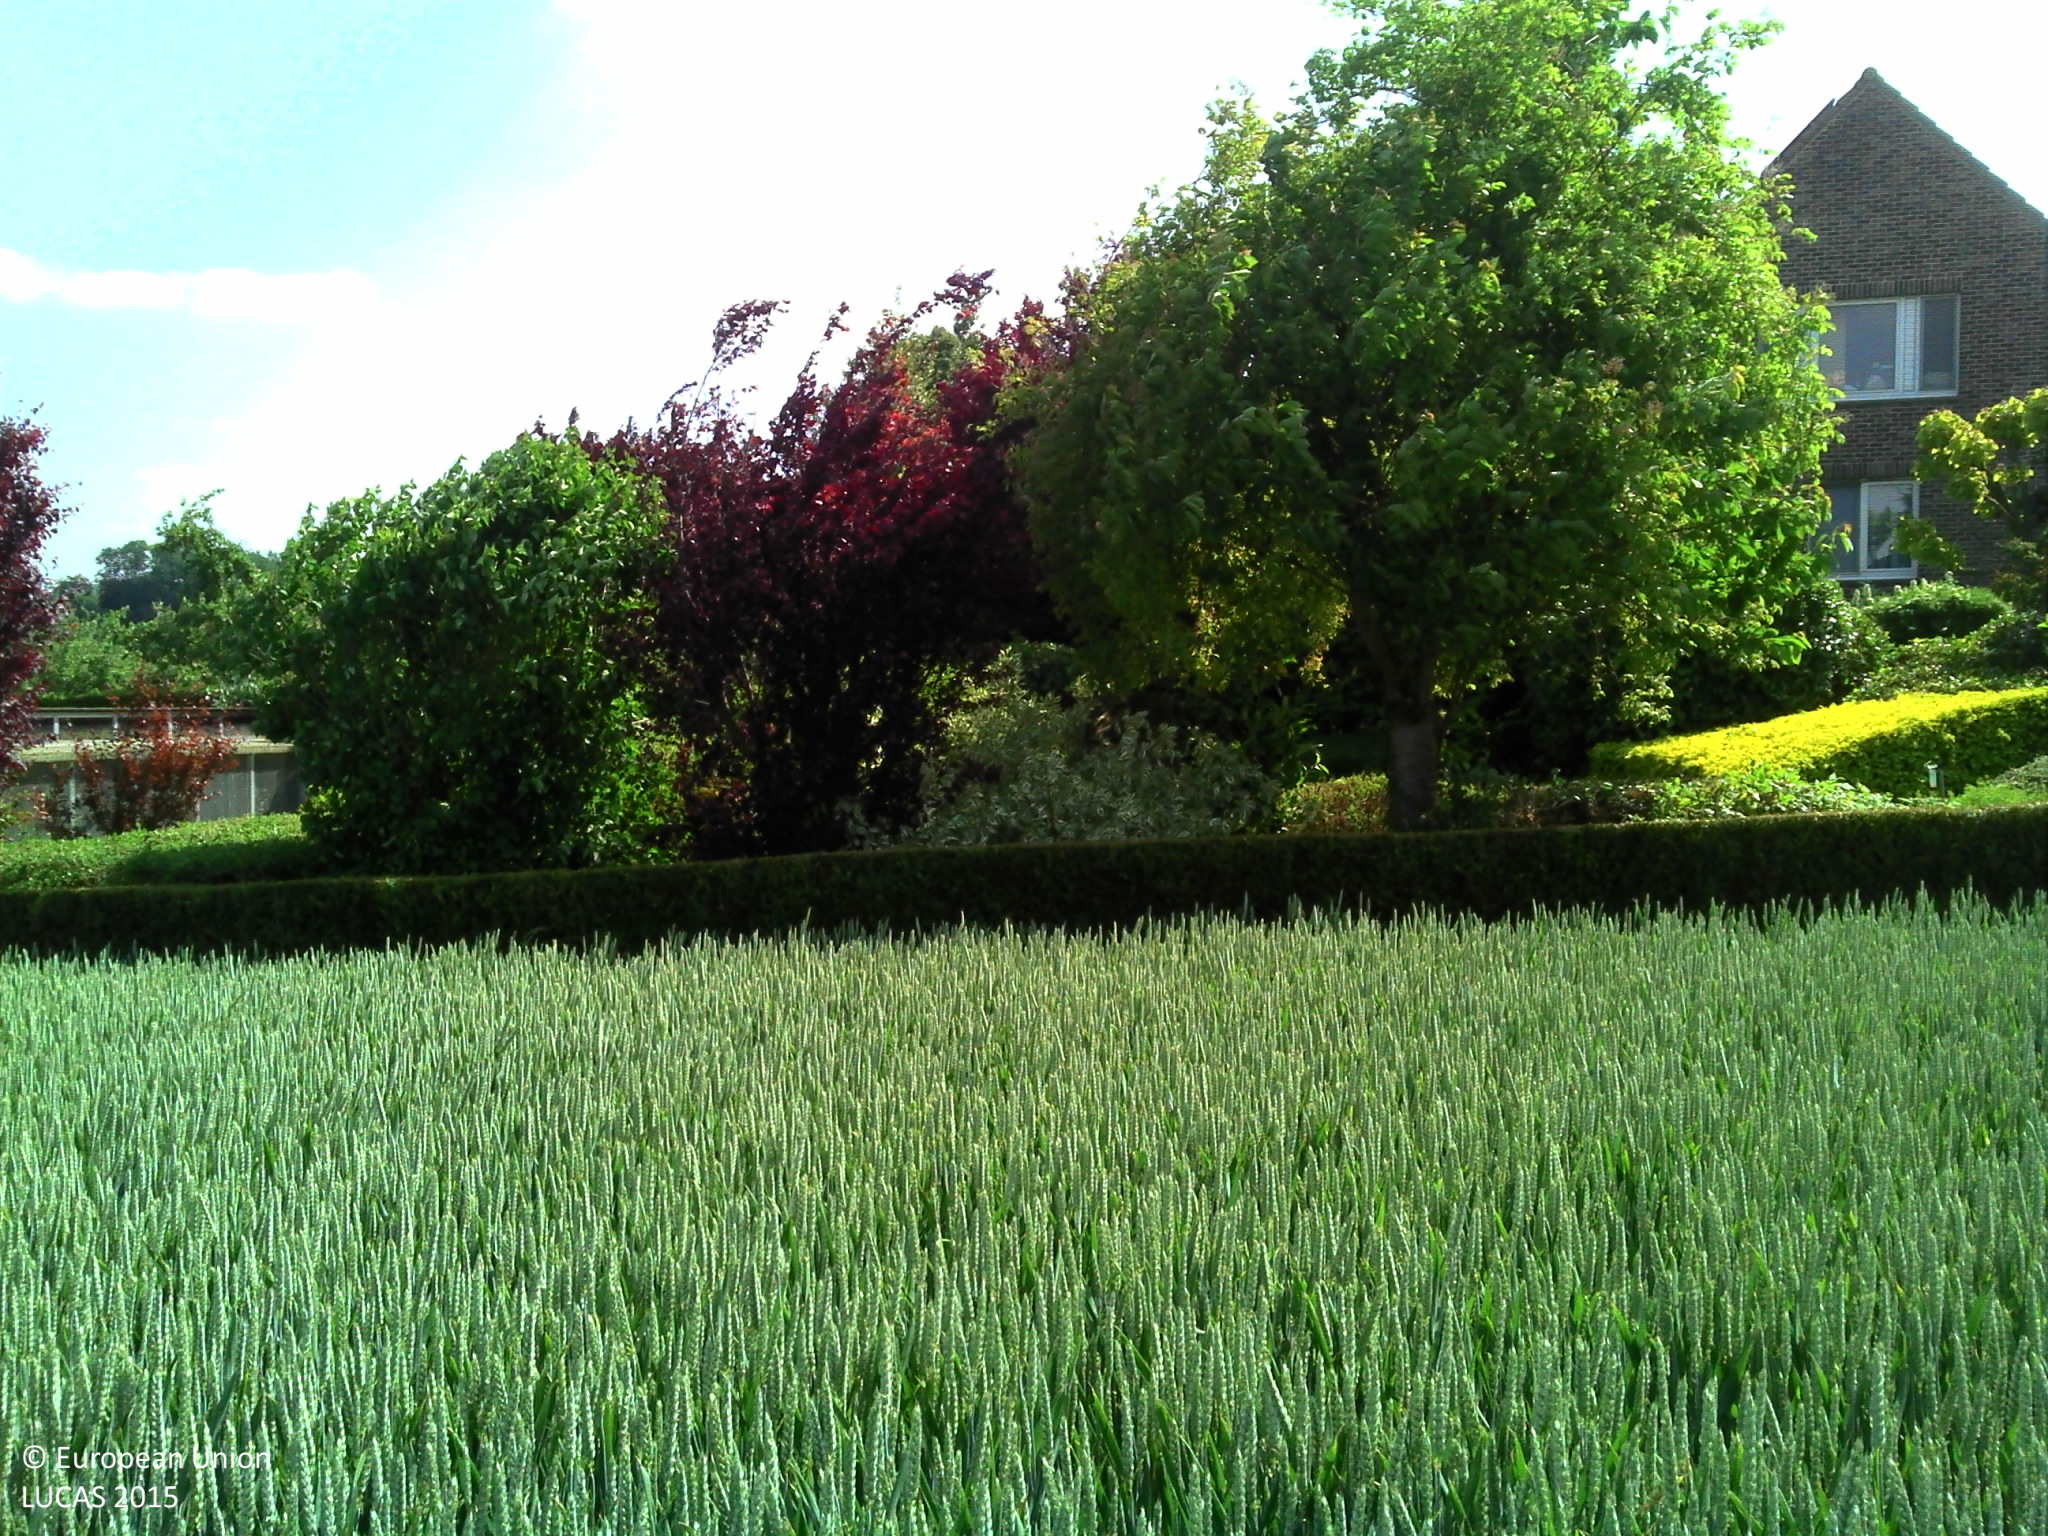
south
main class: Cropland
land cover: Common wheat
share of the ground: > 75 %
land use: Agriculture (excluding fallow land and kitchen gardens)
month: June
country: BE
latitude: 50.7885
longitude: 2.8255
